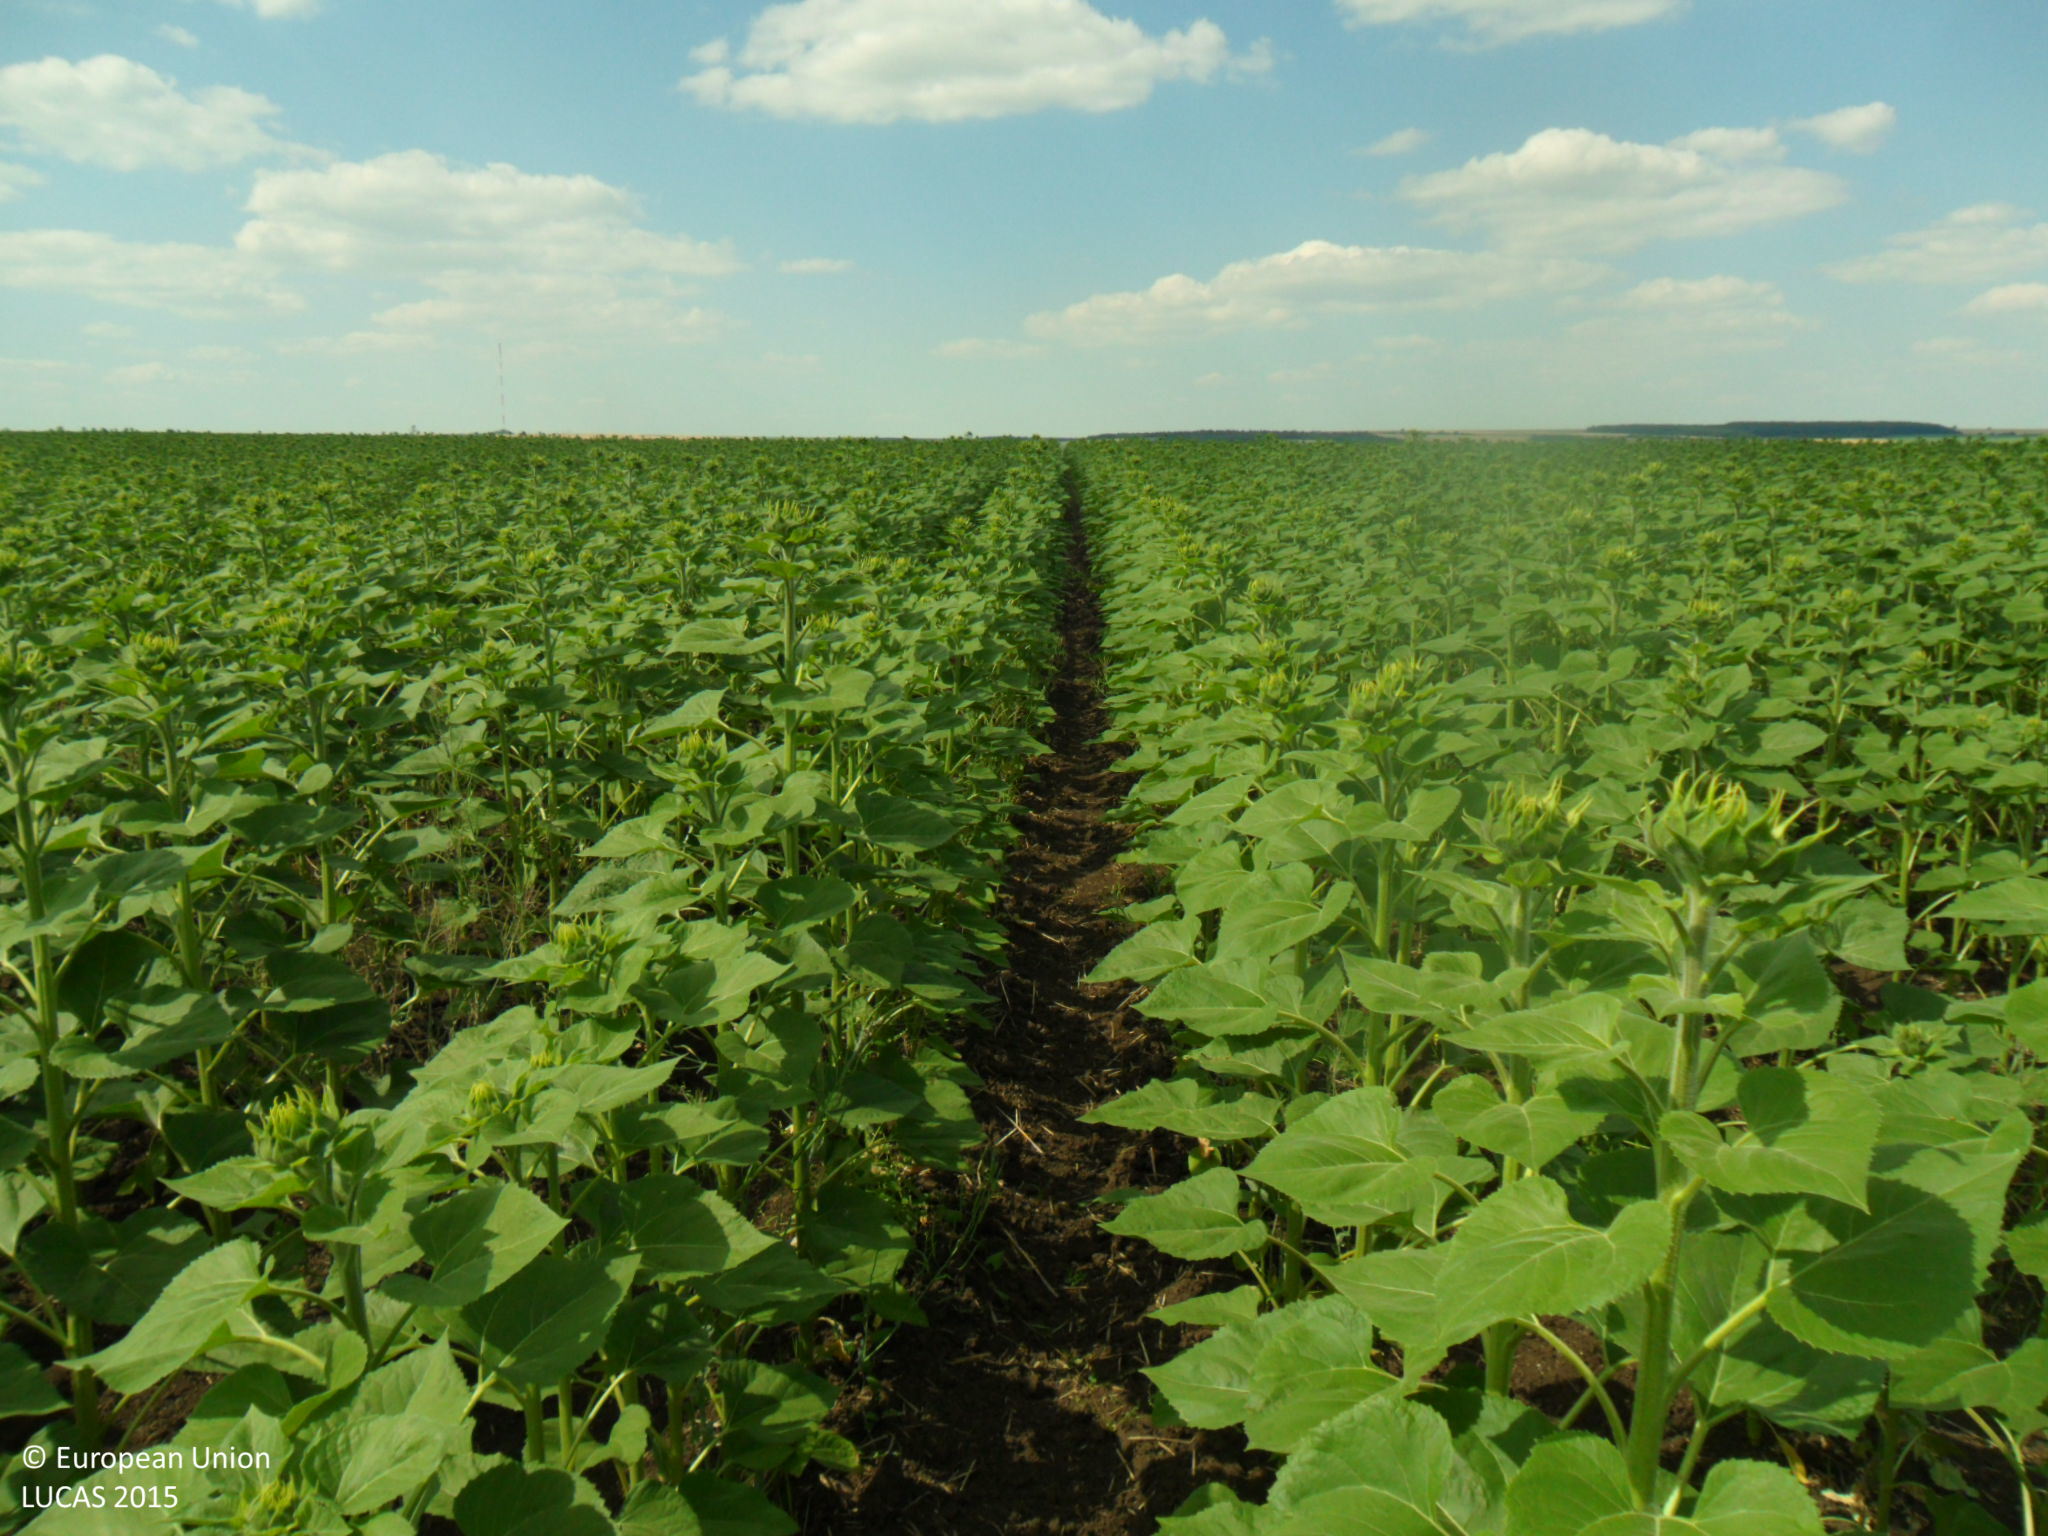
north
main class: Cropland
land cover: Sunflower
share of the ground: > 75 %
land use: Agriculture (excluding fallow land and kitchen gardens)
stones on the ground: < 10 %
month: June
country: BG
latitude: 43.4477
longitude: 26.9072
